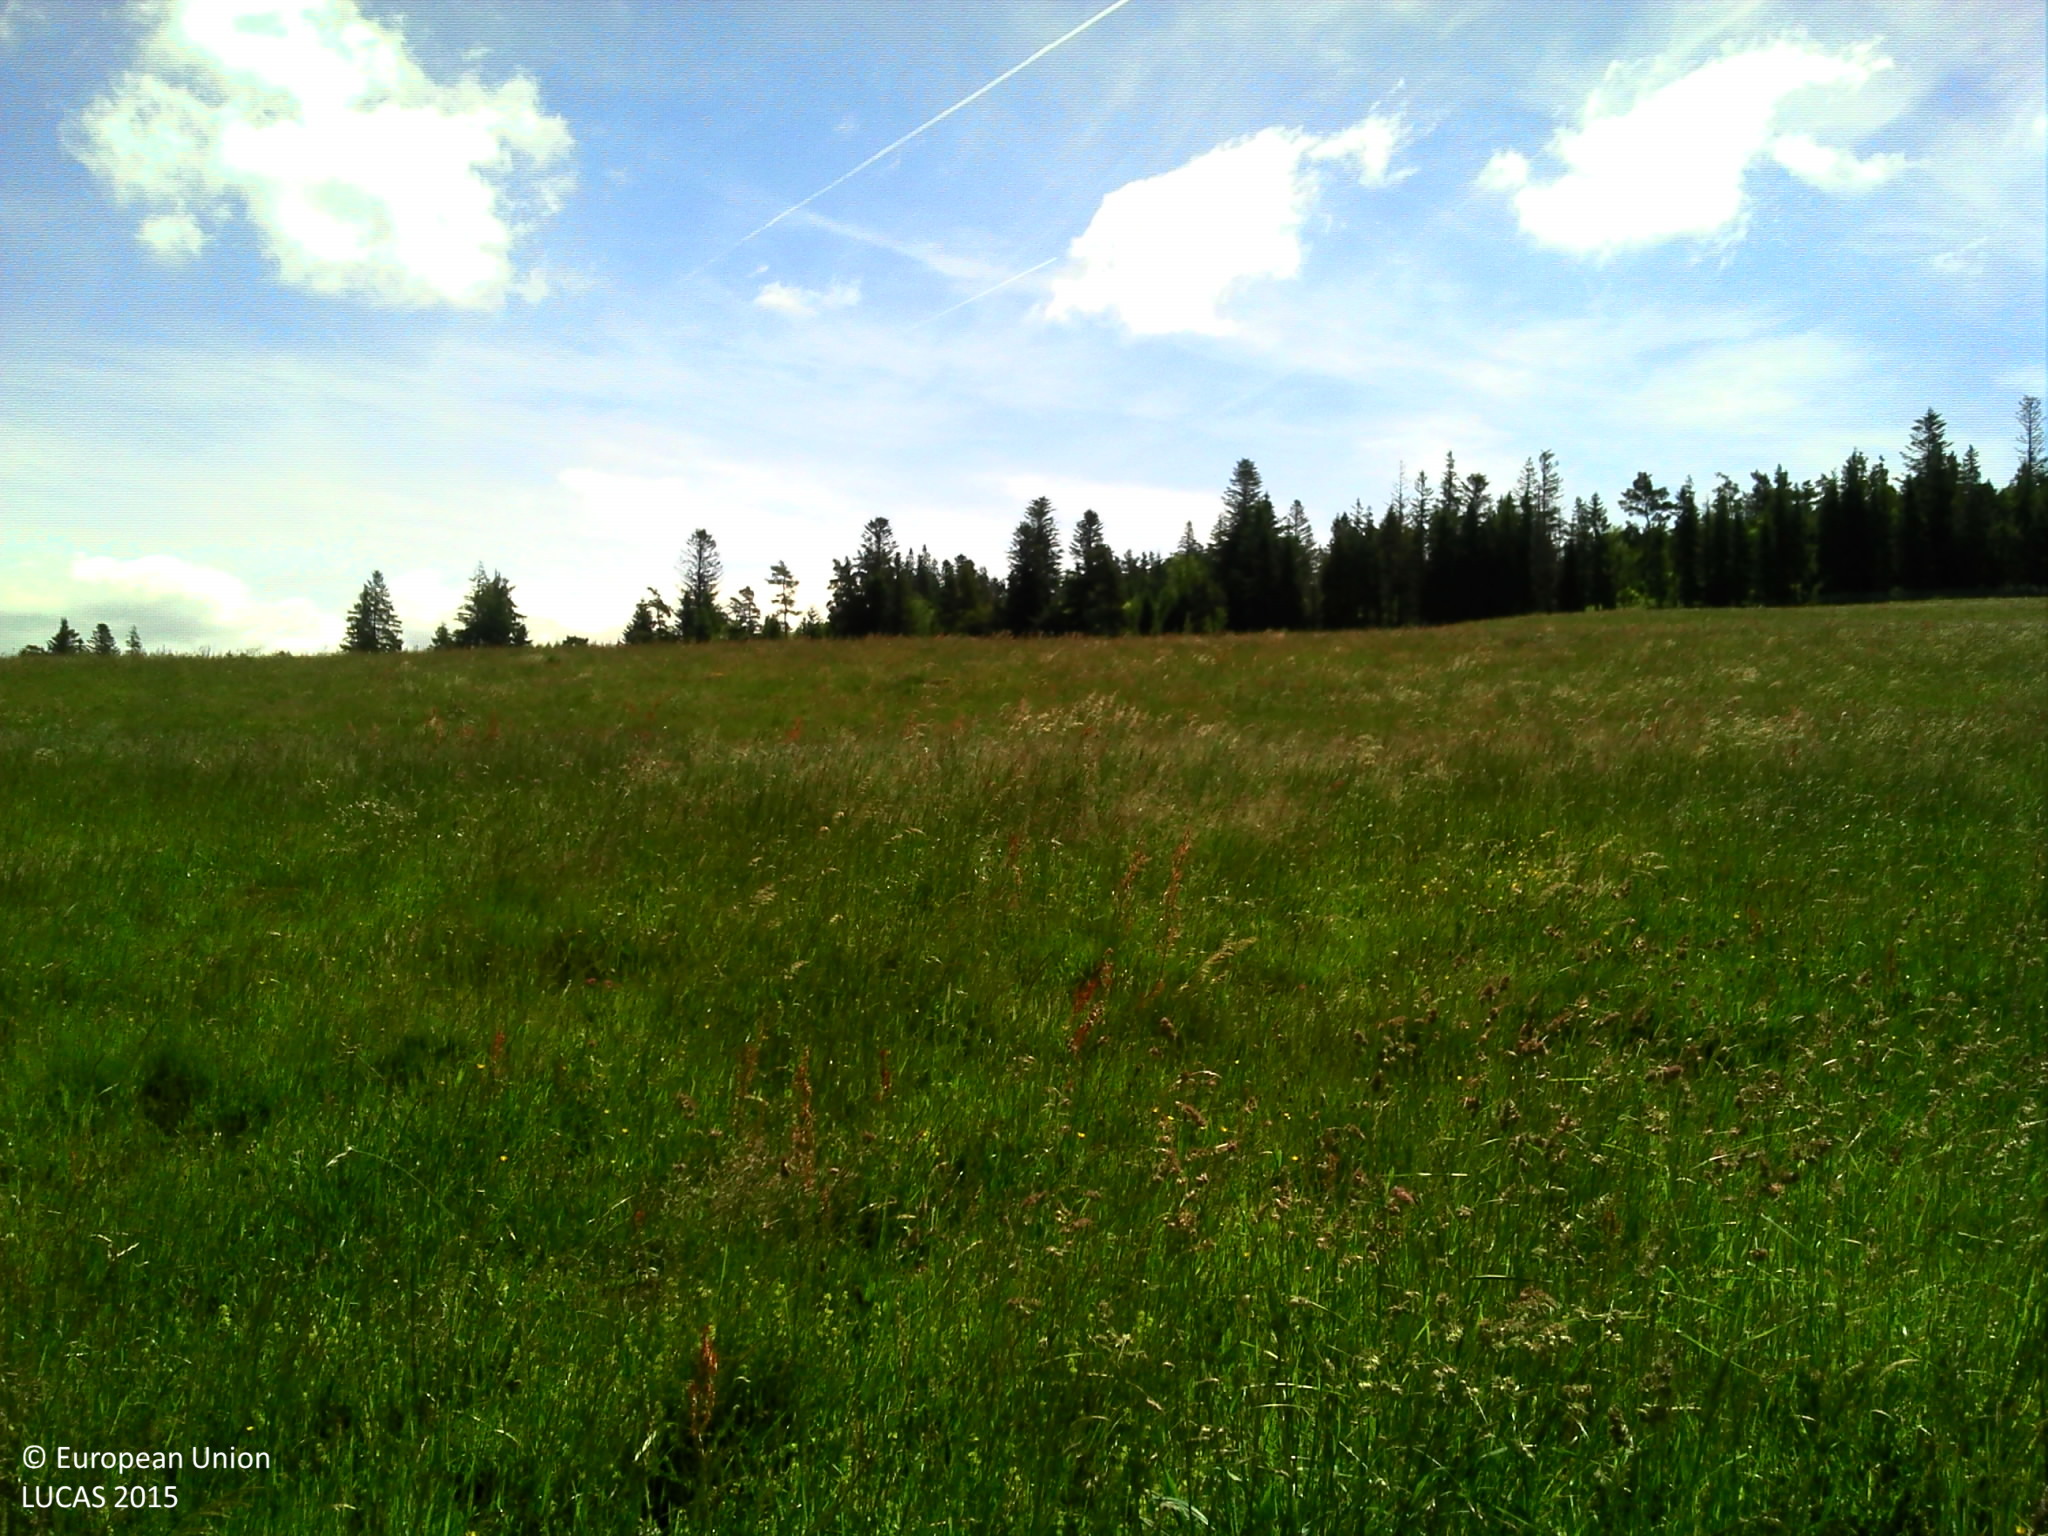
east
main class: Grassland
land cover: Grassland without tree/shrub cover
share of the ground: > 75 %
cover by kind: herbaceous plants 100 %
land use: Agriculture (excluding fallow land and kitchen gardens)
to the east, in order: Grassland without tree/shrub cover; Fences; Grass margins; Tracks; Shrubland with sparse tree cover
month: June
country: FR
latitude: 45.0109
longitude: 2.8836
